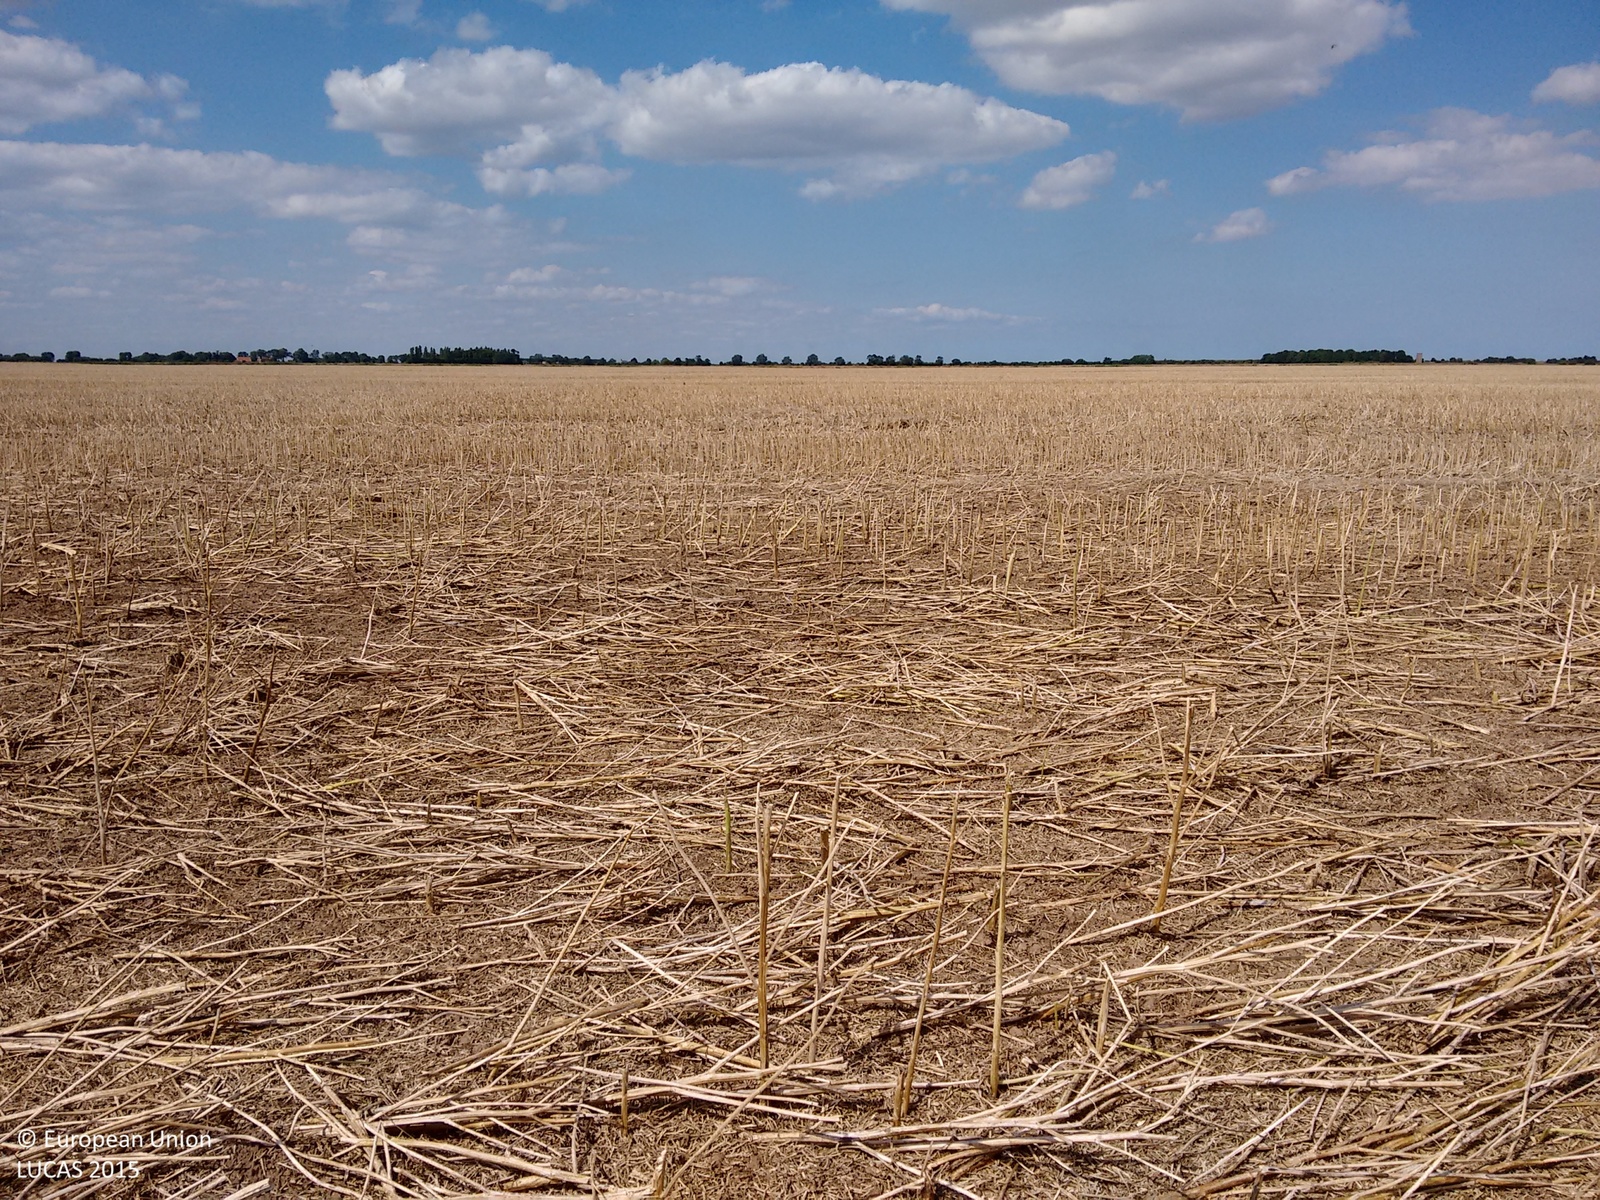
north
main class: Cropland
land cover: Rape and turnip rape
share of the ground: > 75 %
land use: Agriculture (excluding fallow land and kitchen gardens)
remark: Harvested field
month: July
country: GB
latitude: 52.7803
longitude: 0.3495
